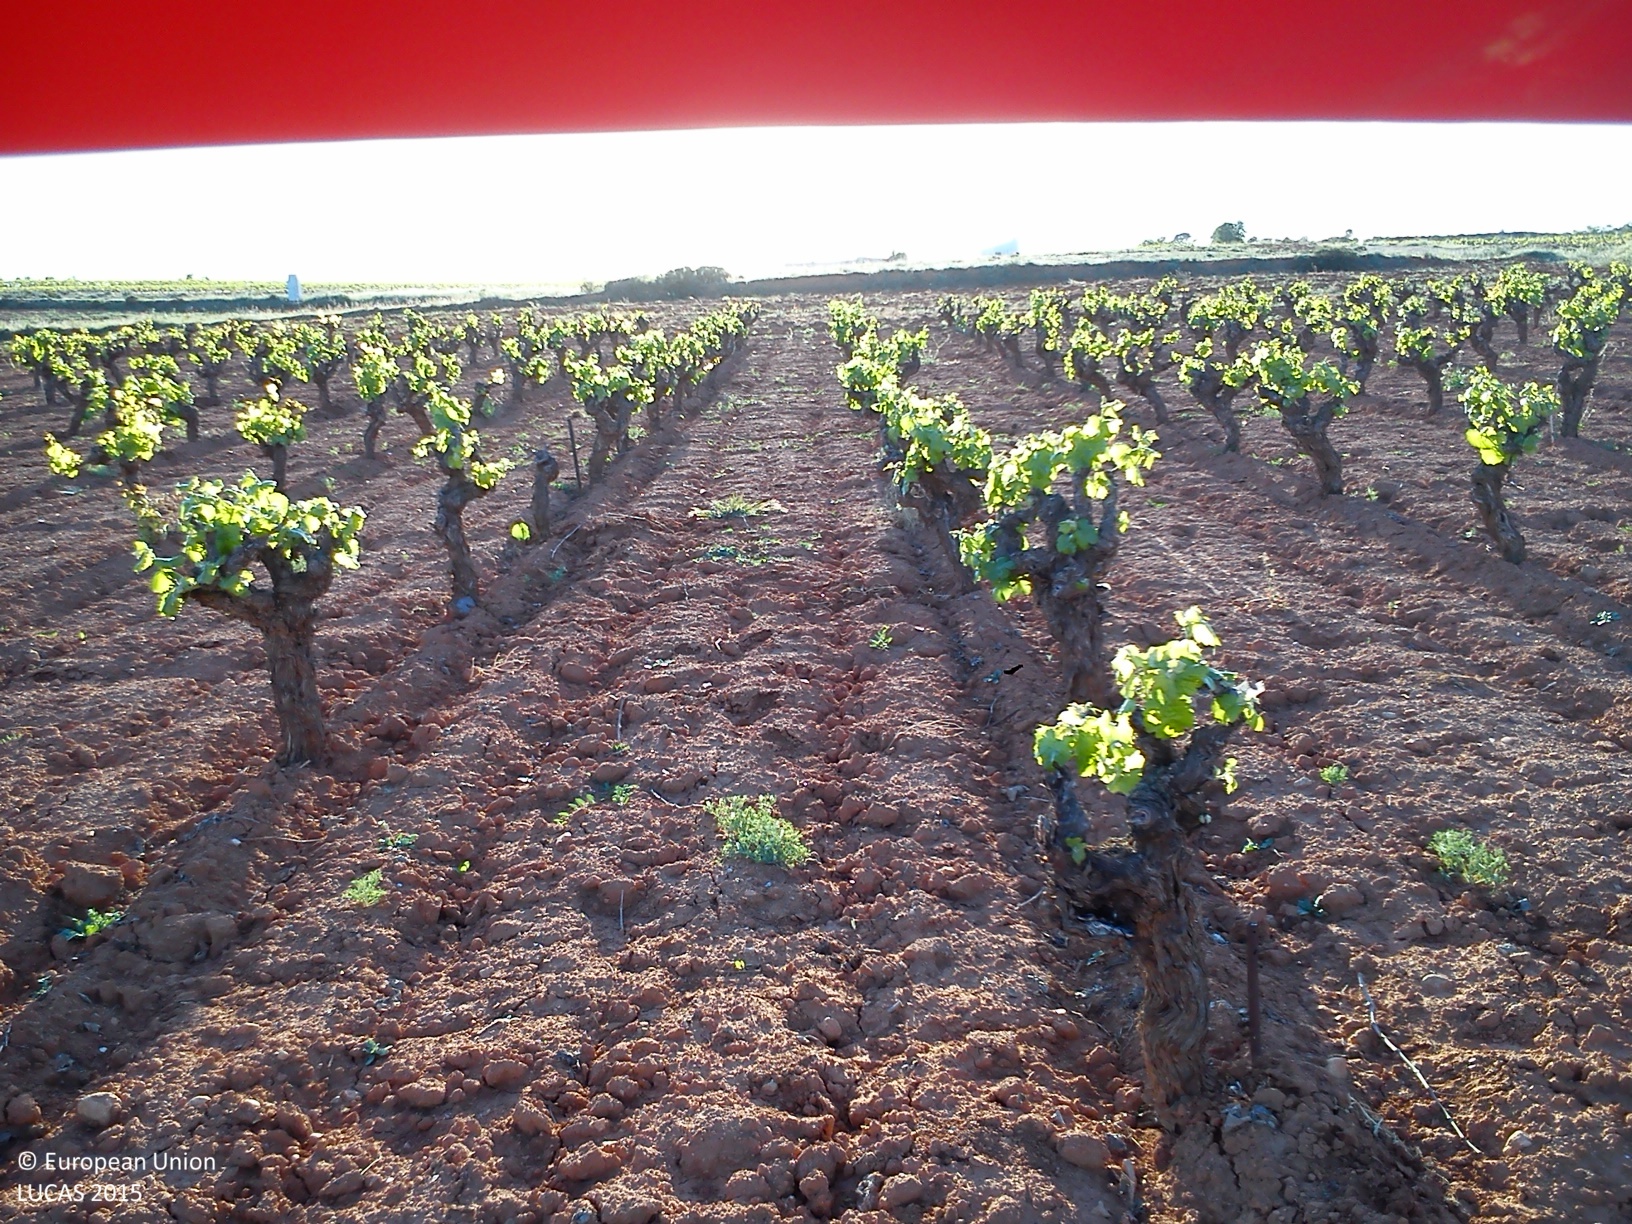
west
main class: Cropland
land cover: Vineyards
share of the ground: 10 - 25 %
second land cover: Other bare soil
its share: > 75 %
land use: Agriculture (excluding fallow land and kitchen gardens)
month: May
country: ES
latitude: 39.5094
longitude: -1.0853
